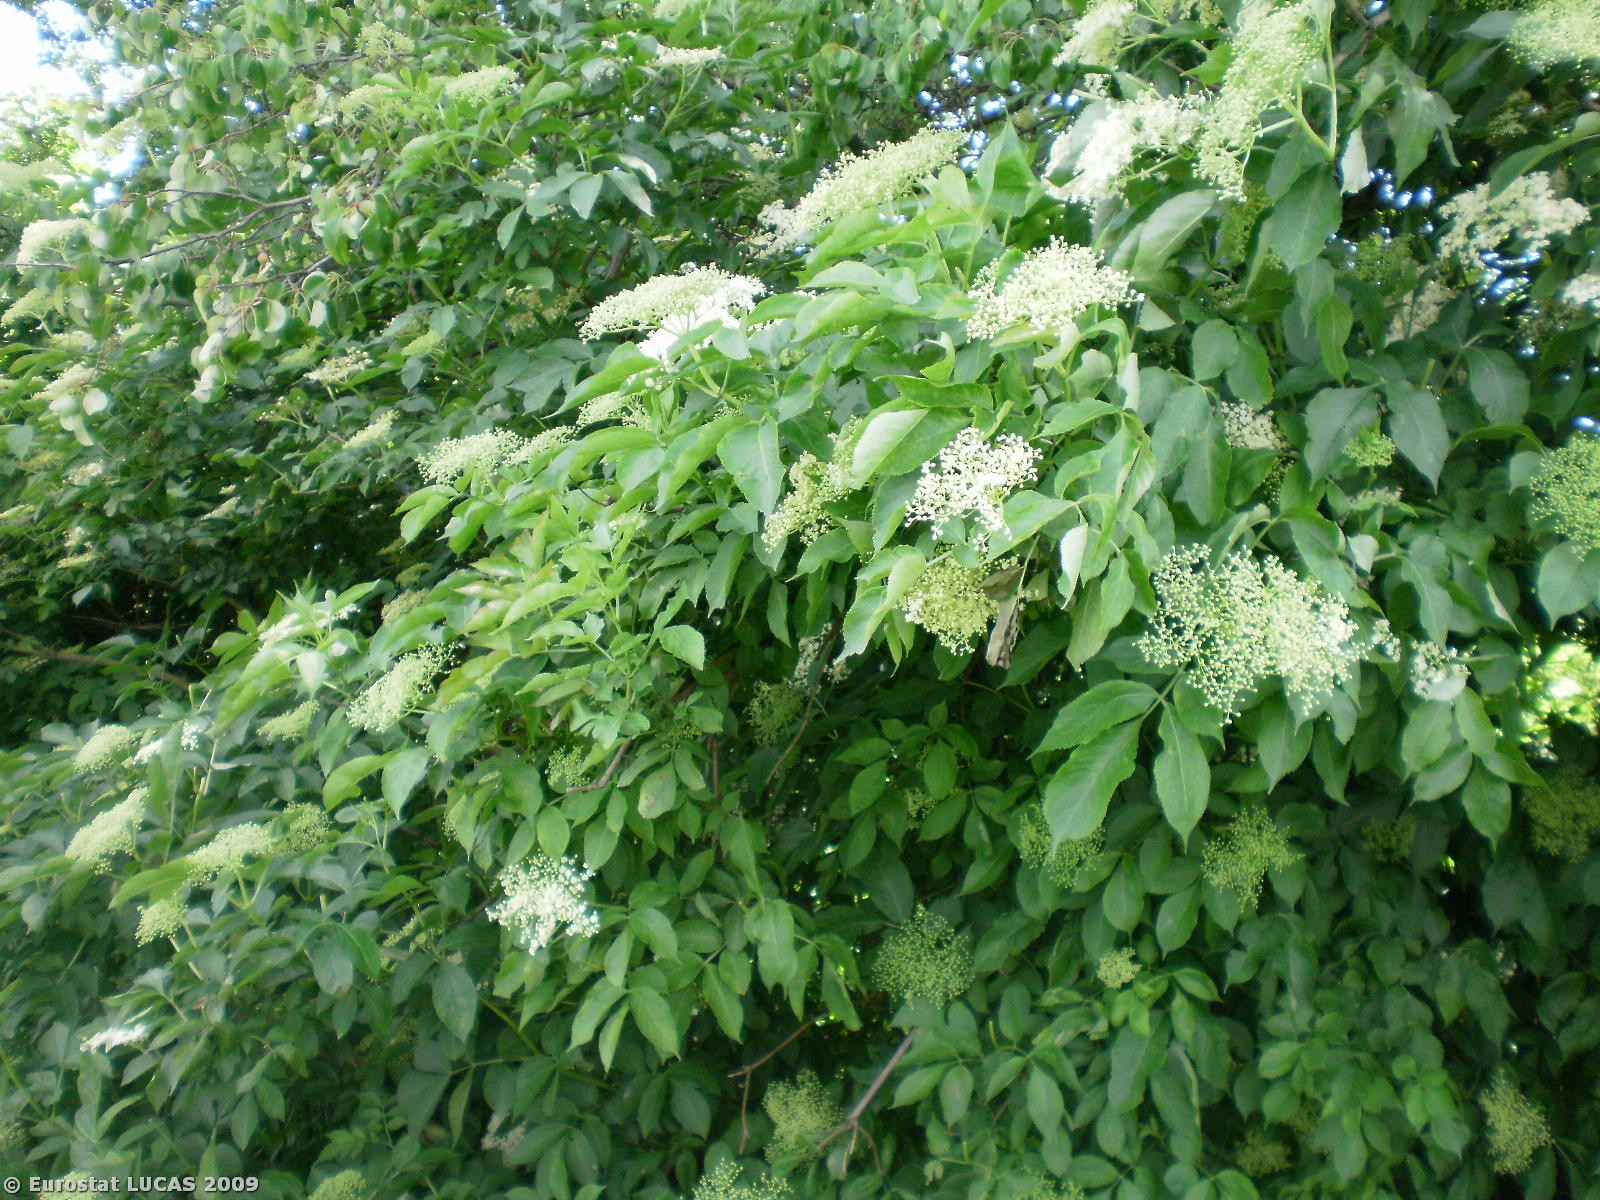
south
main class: Cropland
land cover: Barley
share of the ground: > 75 %
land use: Agriculture (excluding fallow land and kitchen gardens)
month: June
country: PL
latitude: 53.3979
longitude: 19.8510
